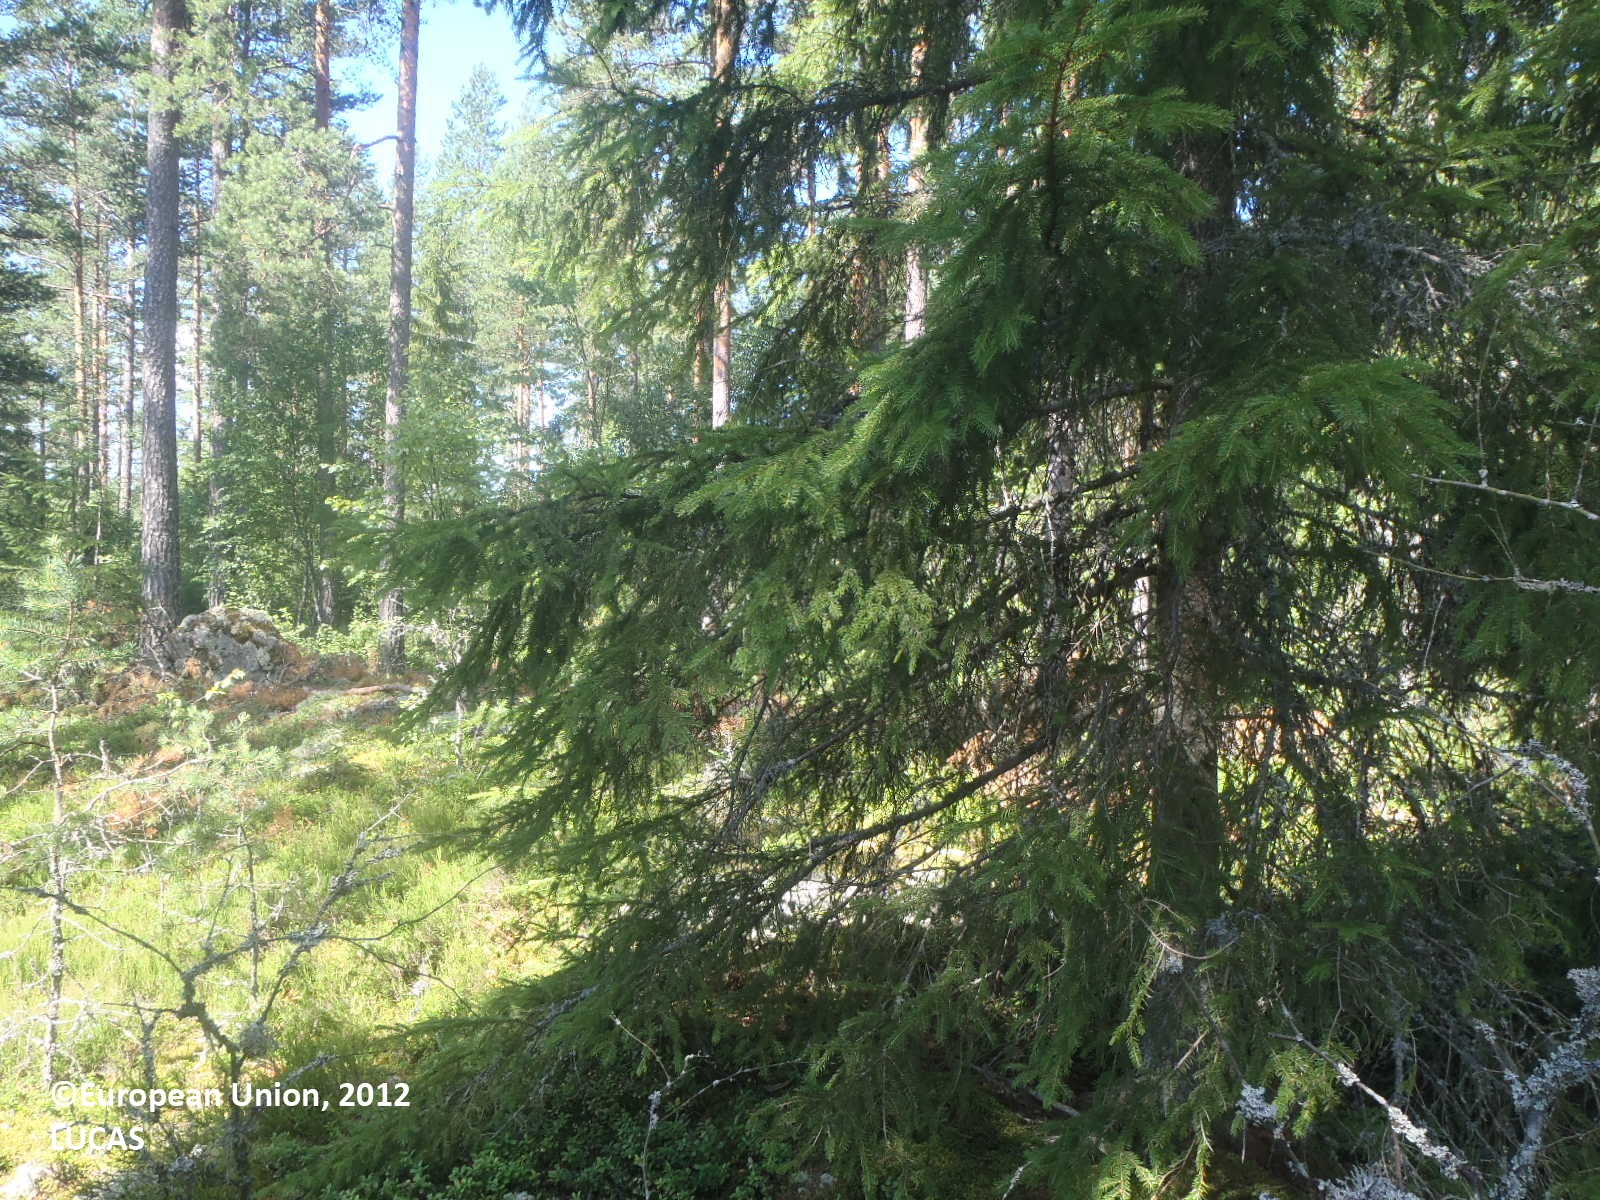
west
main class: Woodland
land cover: Spruce dominated coniferous woodland
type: boreal forest
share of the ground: 50 - 75 %
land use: Forestry
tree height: > 5 m
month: July
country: FI
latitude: 61.0291
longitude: 21.8472
